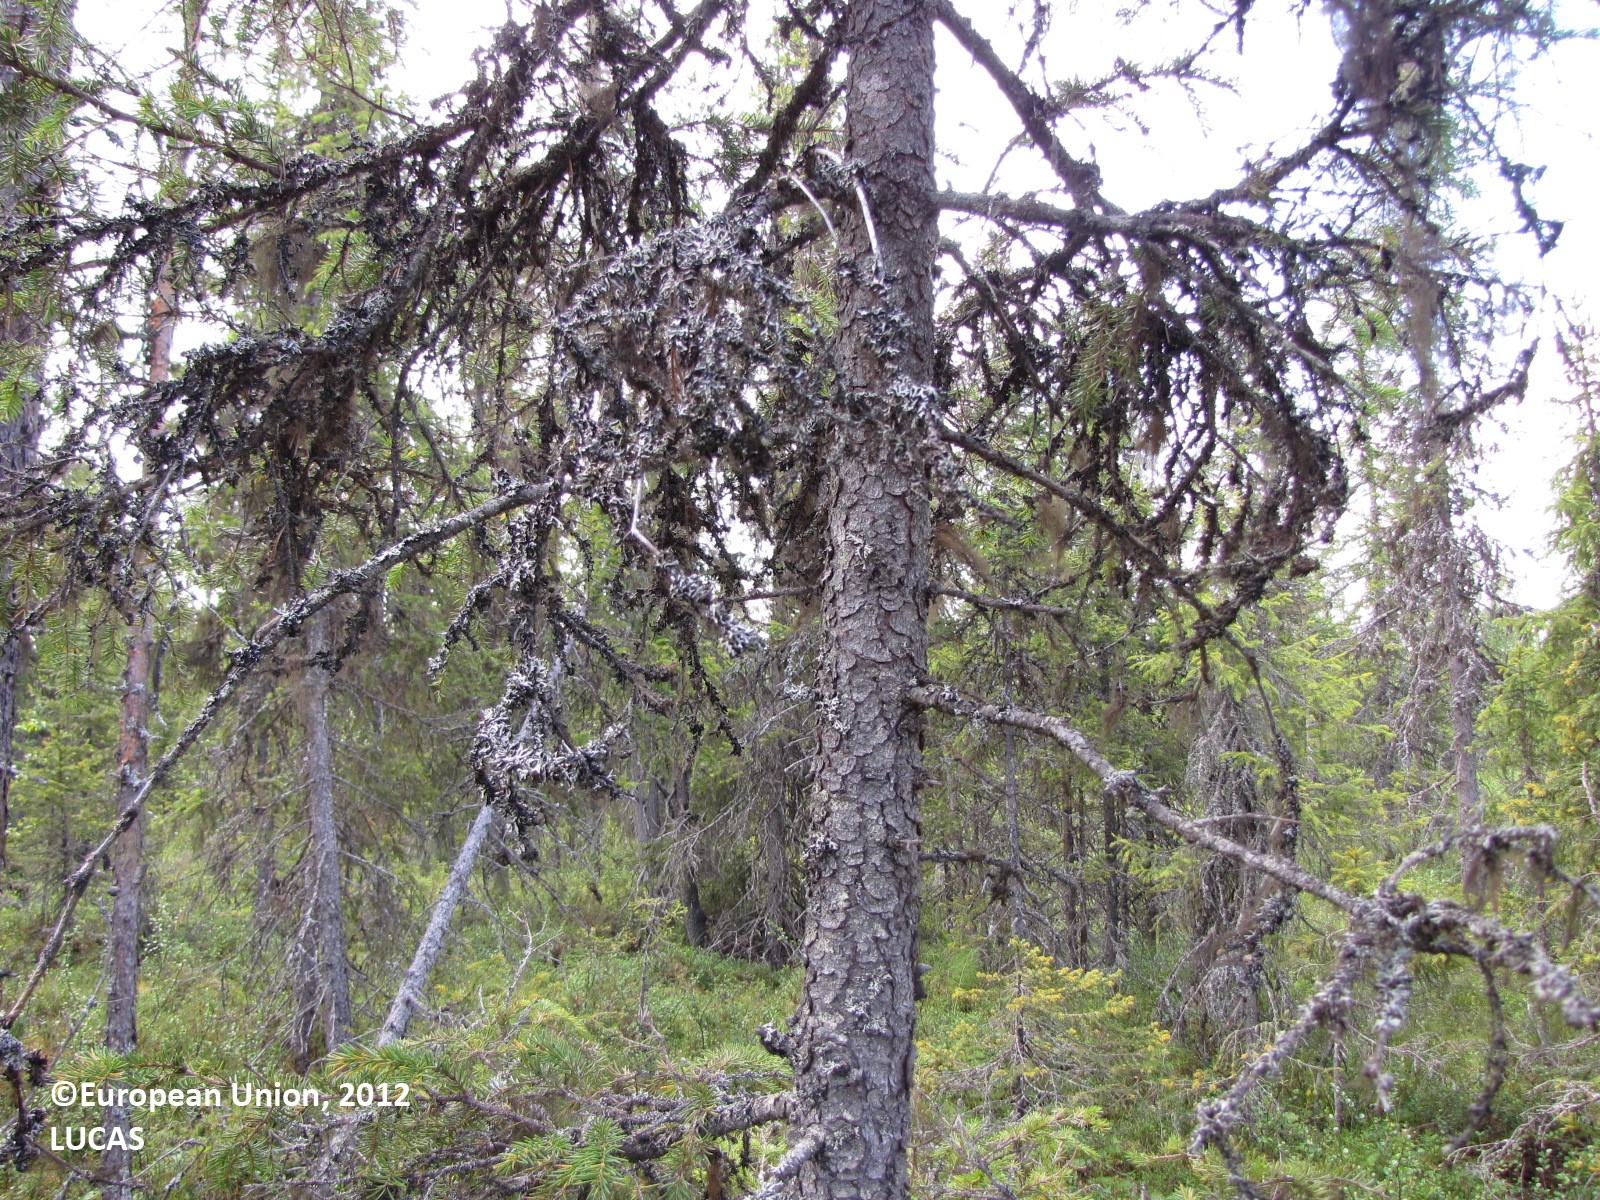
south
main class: Woodland
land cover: Spruce dominated coniferous woodland
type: boreal forest
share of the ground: 25 - 50 %
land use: Forestry
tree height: > 5 m
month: August
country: FI
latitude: 66.8599
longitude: 24.5667
